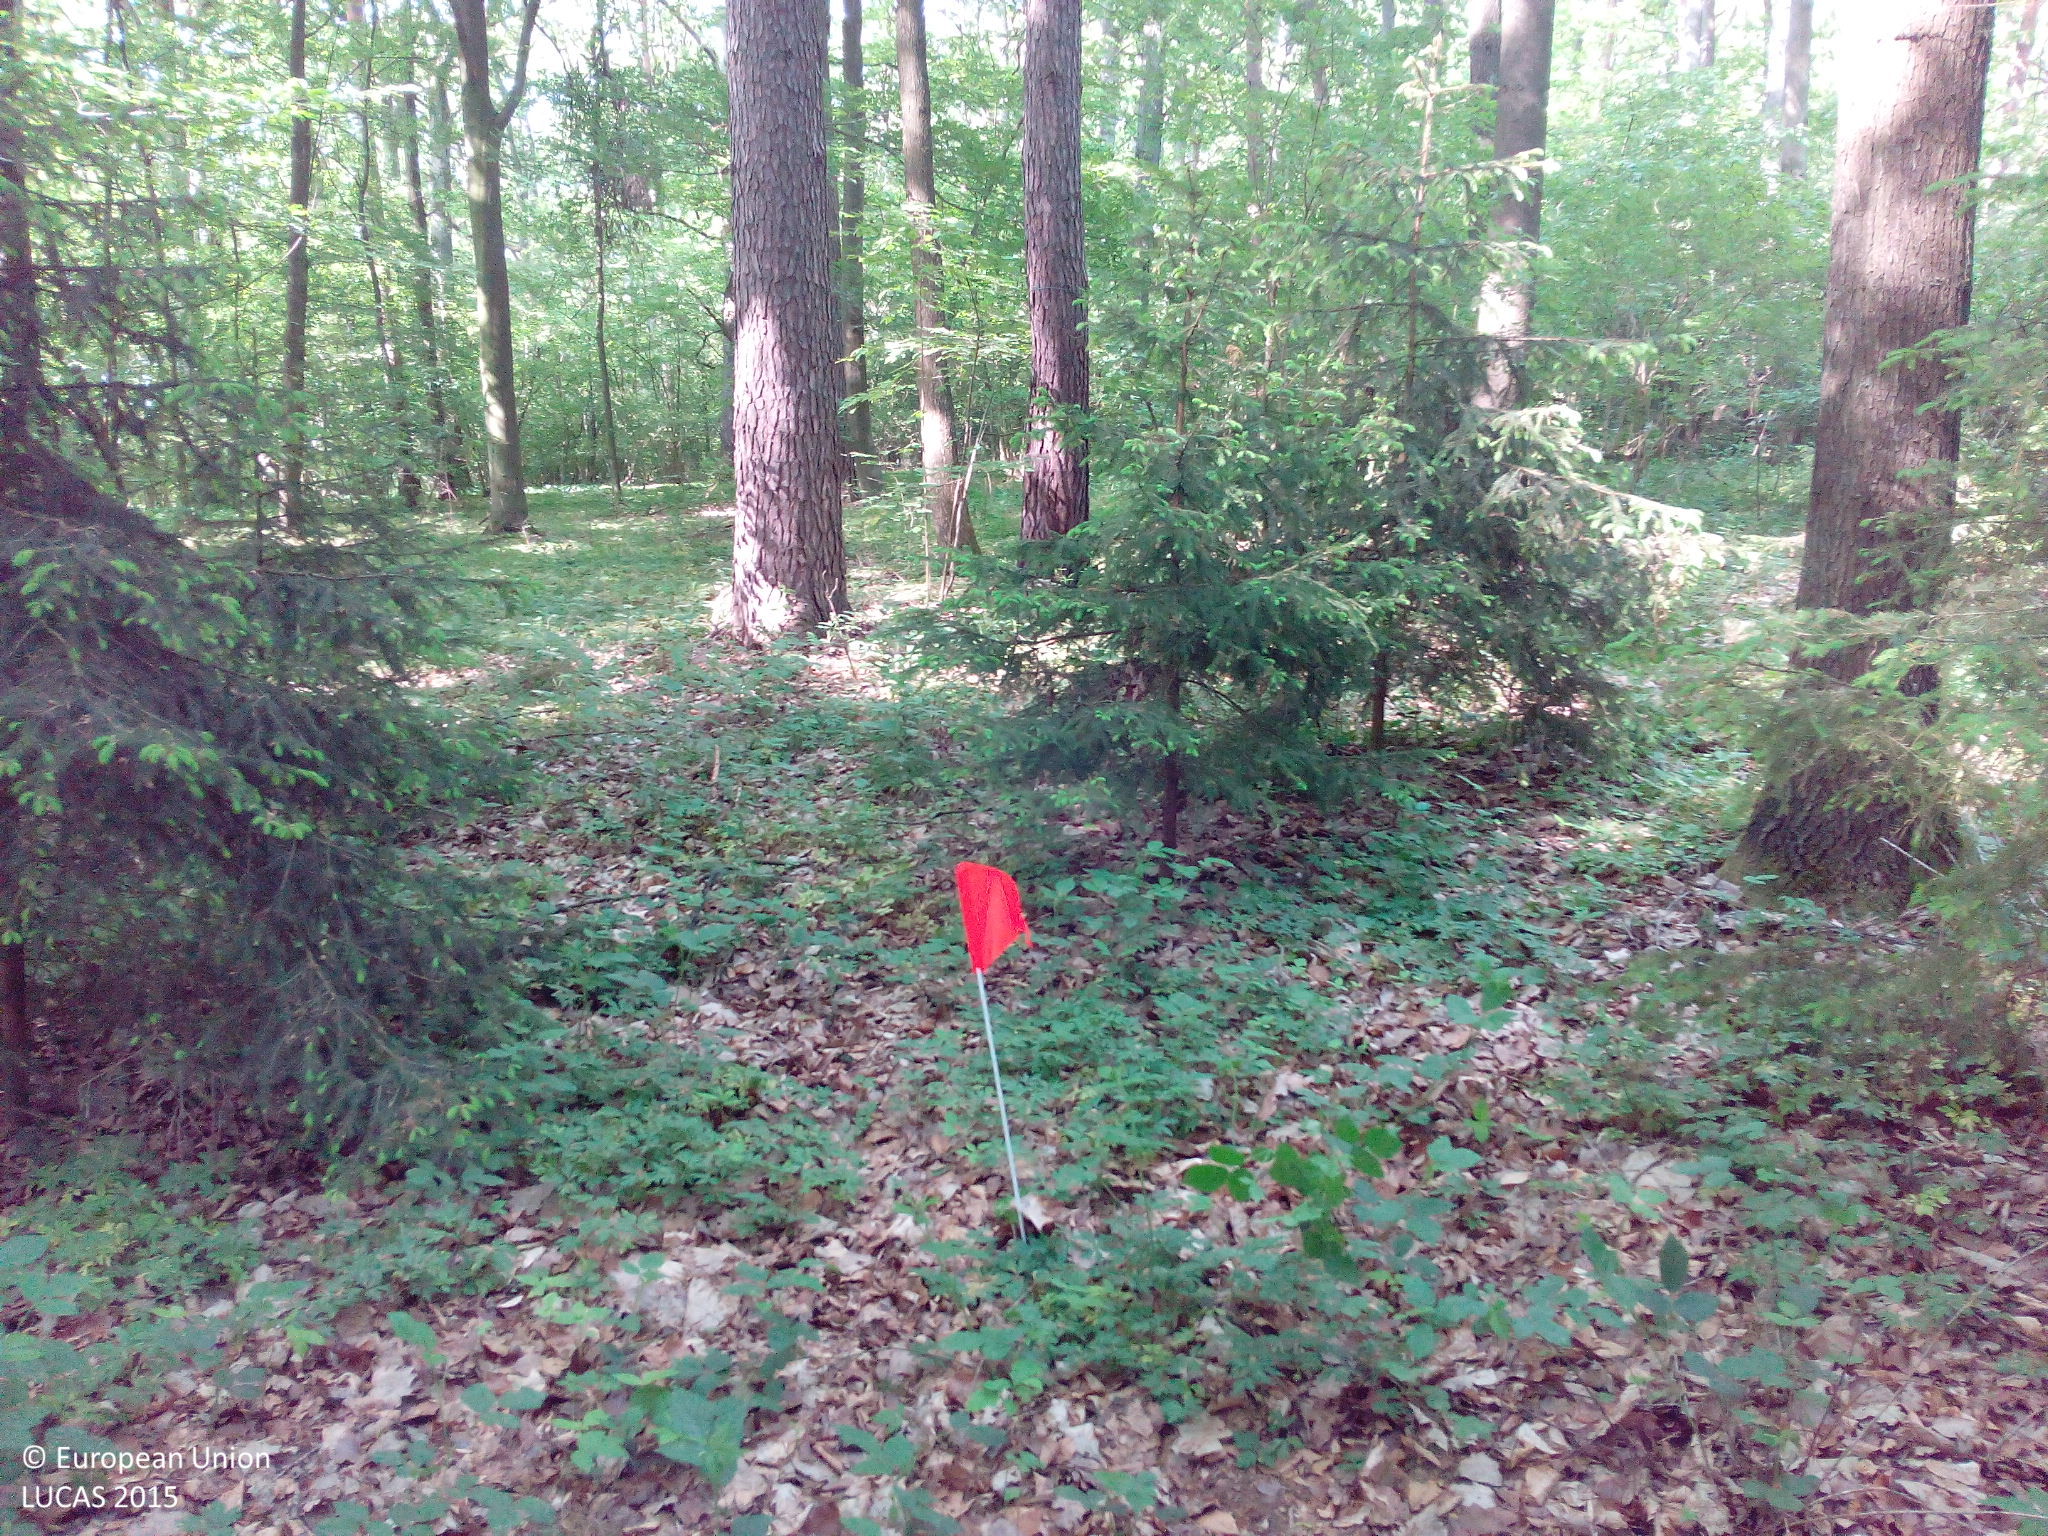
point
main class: Woodland
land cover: Broadleaved woodland
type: mesophytic deciduous forest
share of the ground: > 75 %
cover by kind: broadleaved forest trees 85 %, coniferous forest trees 10 %, herbaceous plants 5 %
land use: Forestry
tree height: > 5 m
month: May
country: DE
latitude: 50.0907
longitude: 10.9083
